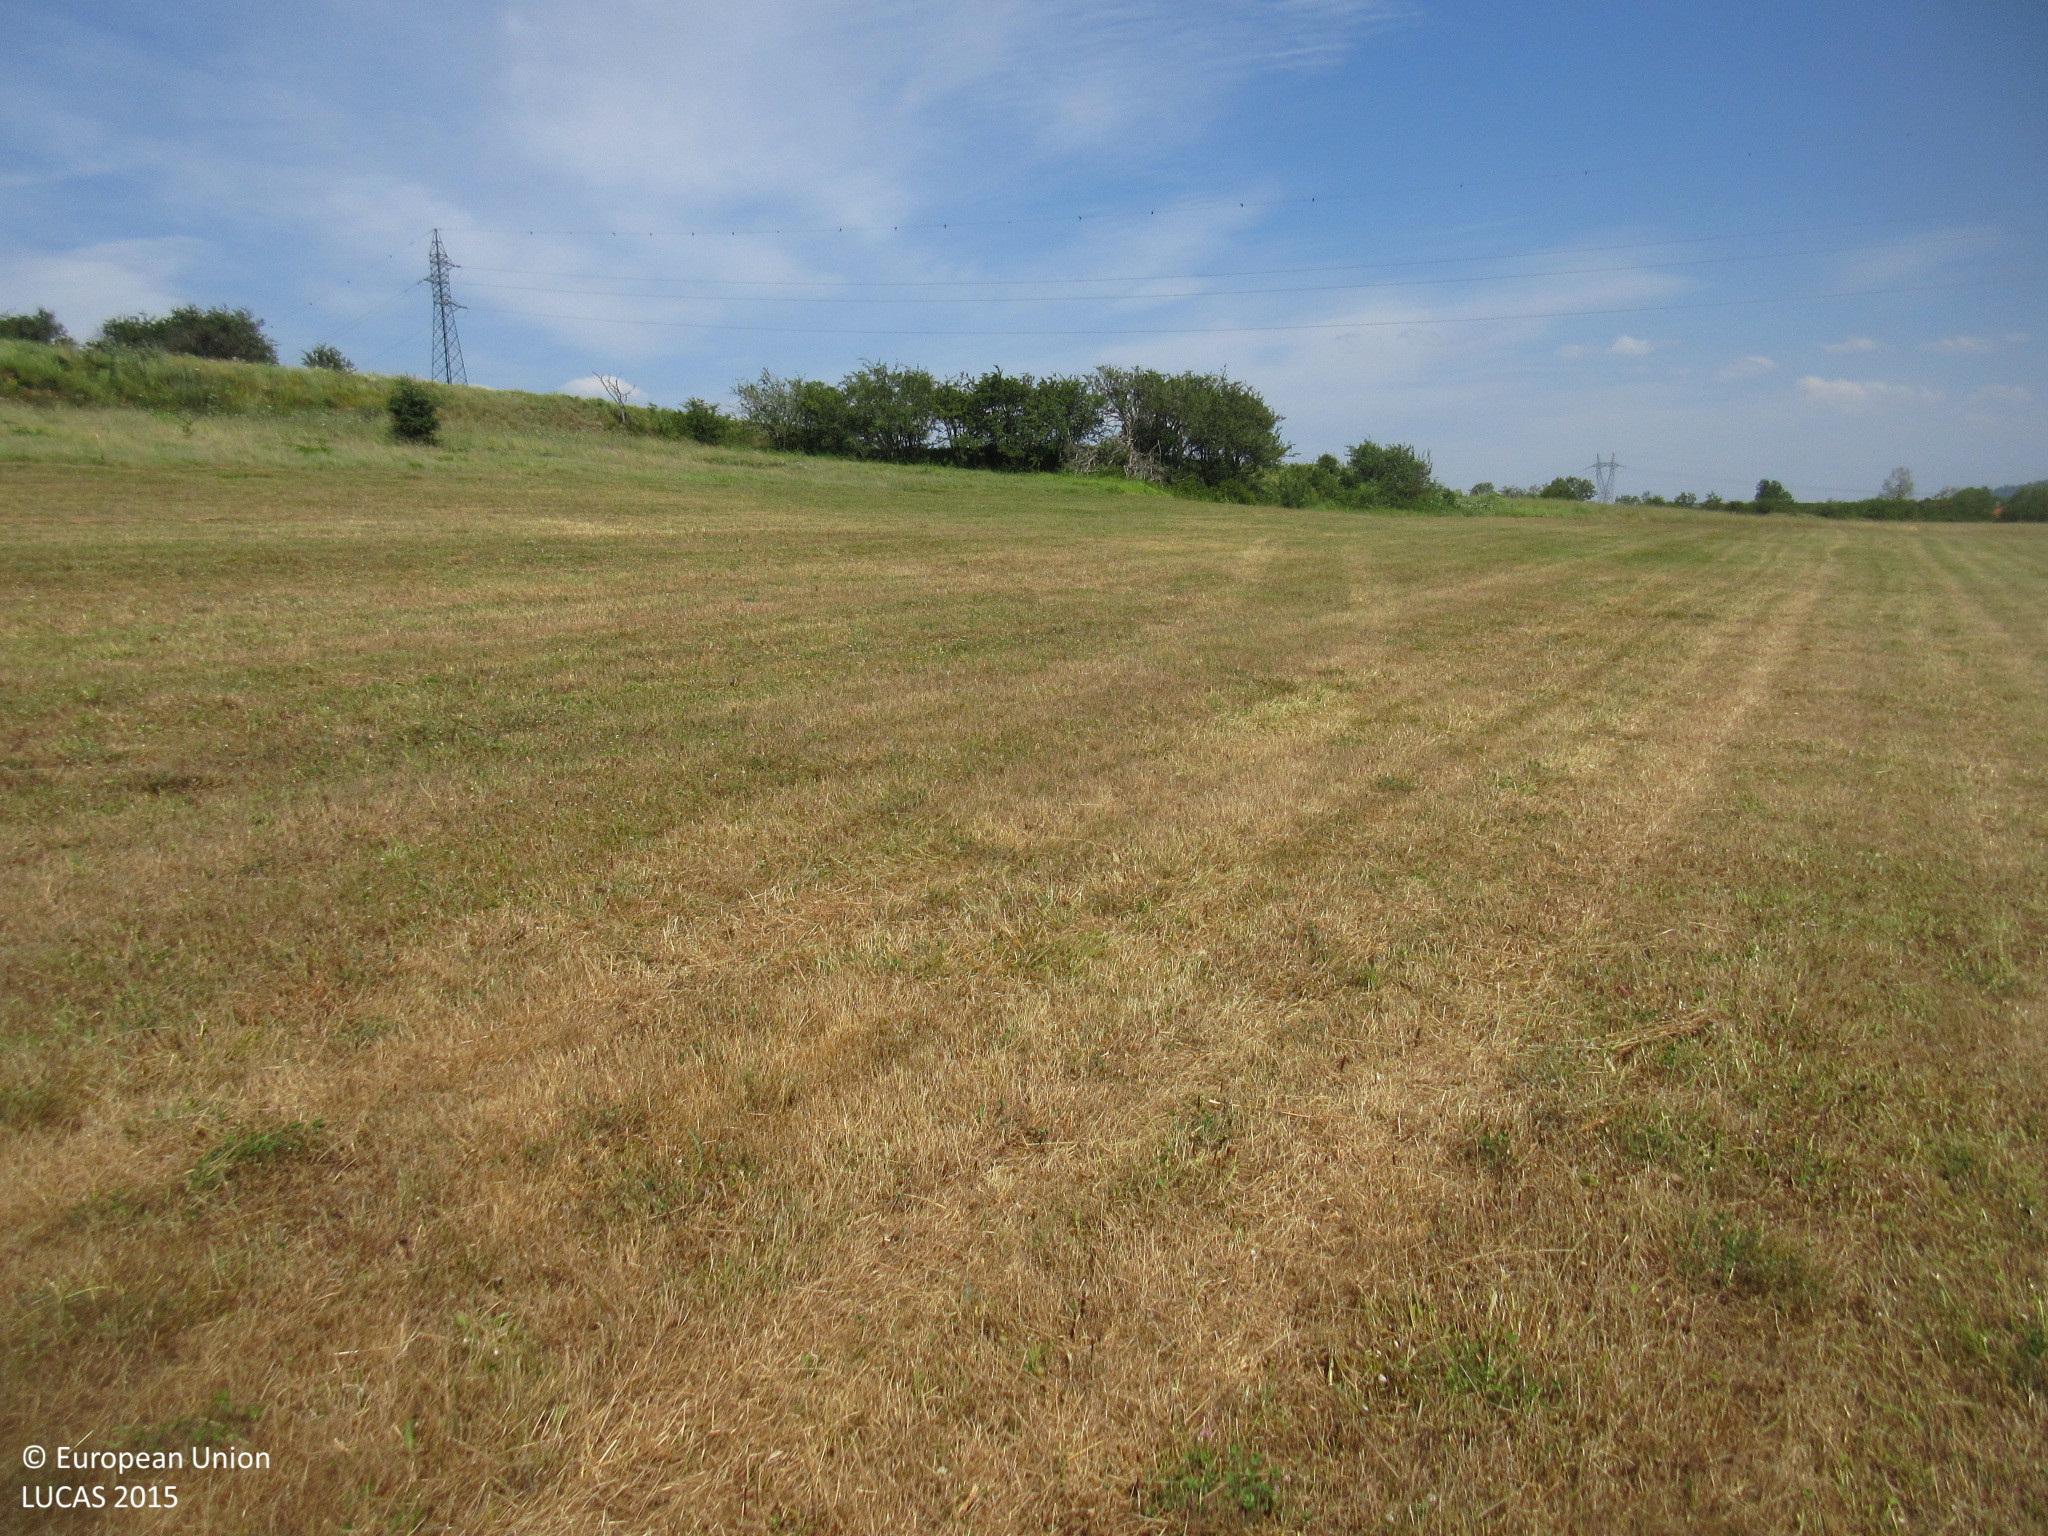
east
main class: Grassland
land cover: Grassland without tree/shrub cover
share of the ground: > 75 %
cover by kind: herbaceous plants 100 %
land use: Agriculture (excluding fallow land and kitchen gardens)
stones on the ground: 25 - 50 %
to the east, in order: Grassland without tree/shrub cover; Spontaneously vegetated surfaces; Groves; Grassland without tree/shrub cover; Shrubland with sparse tree cover
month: July
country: ES
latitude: 42.9725
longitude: -3.8887
